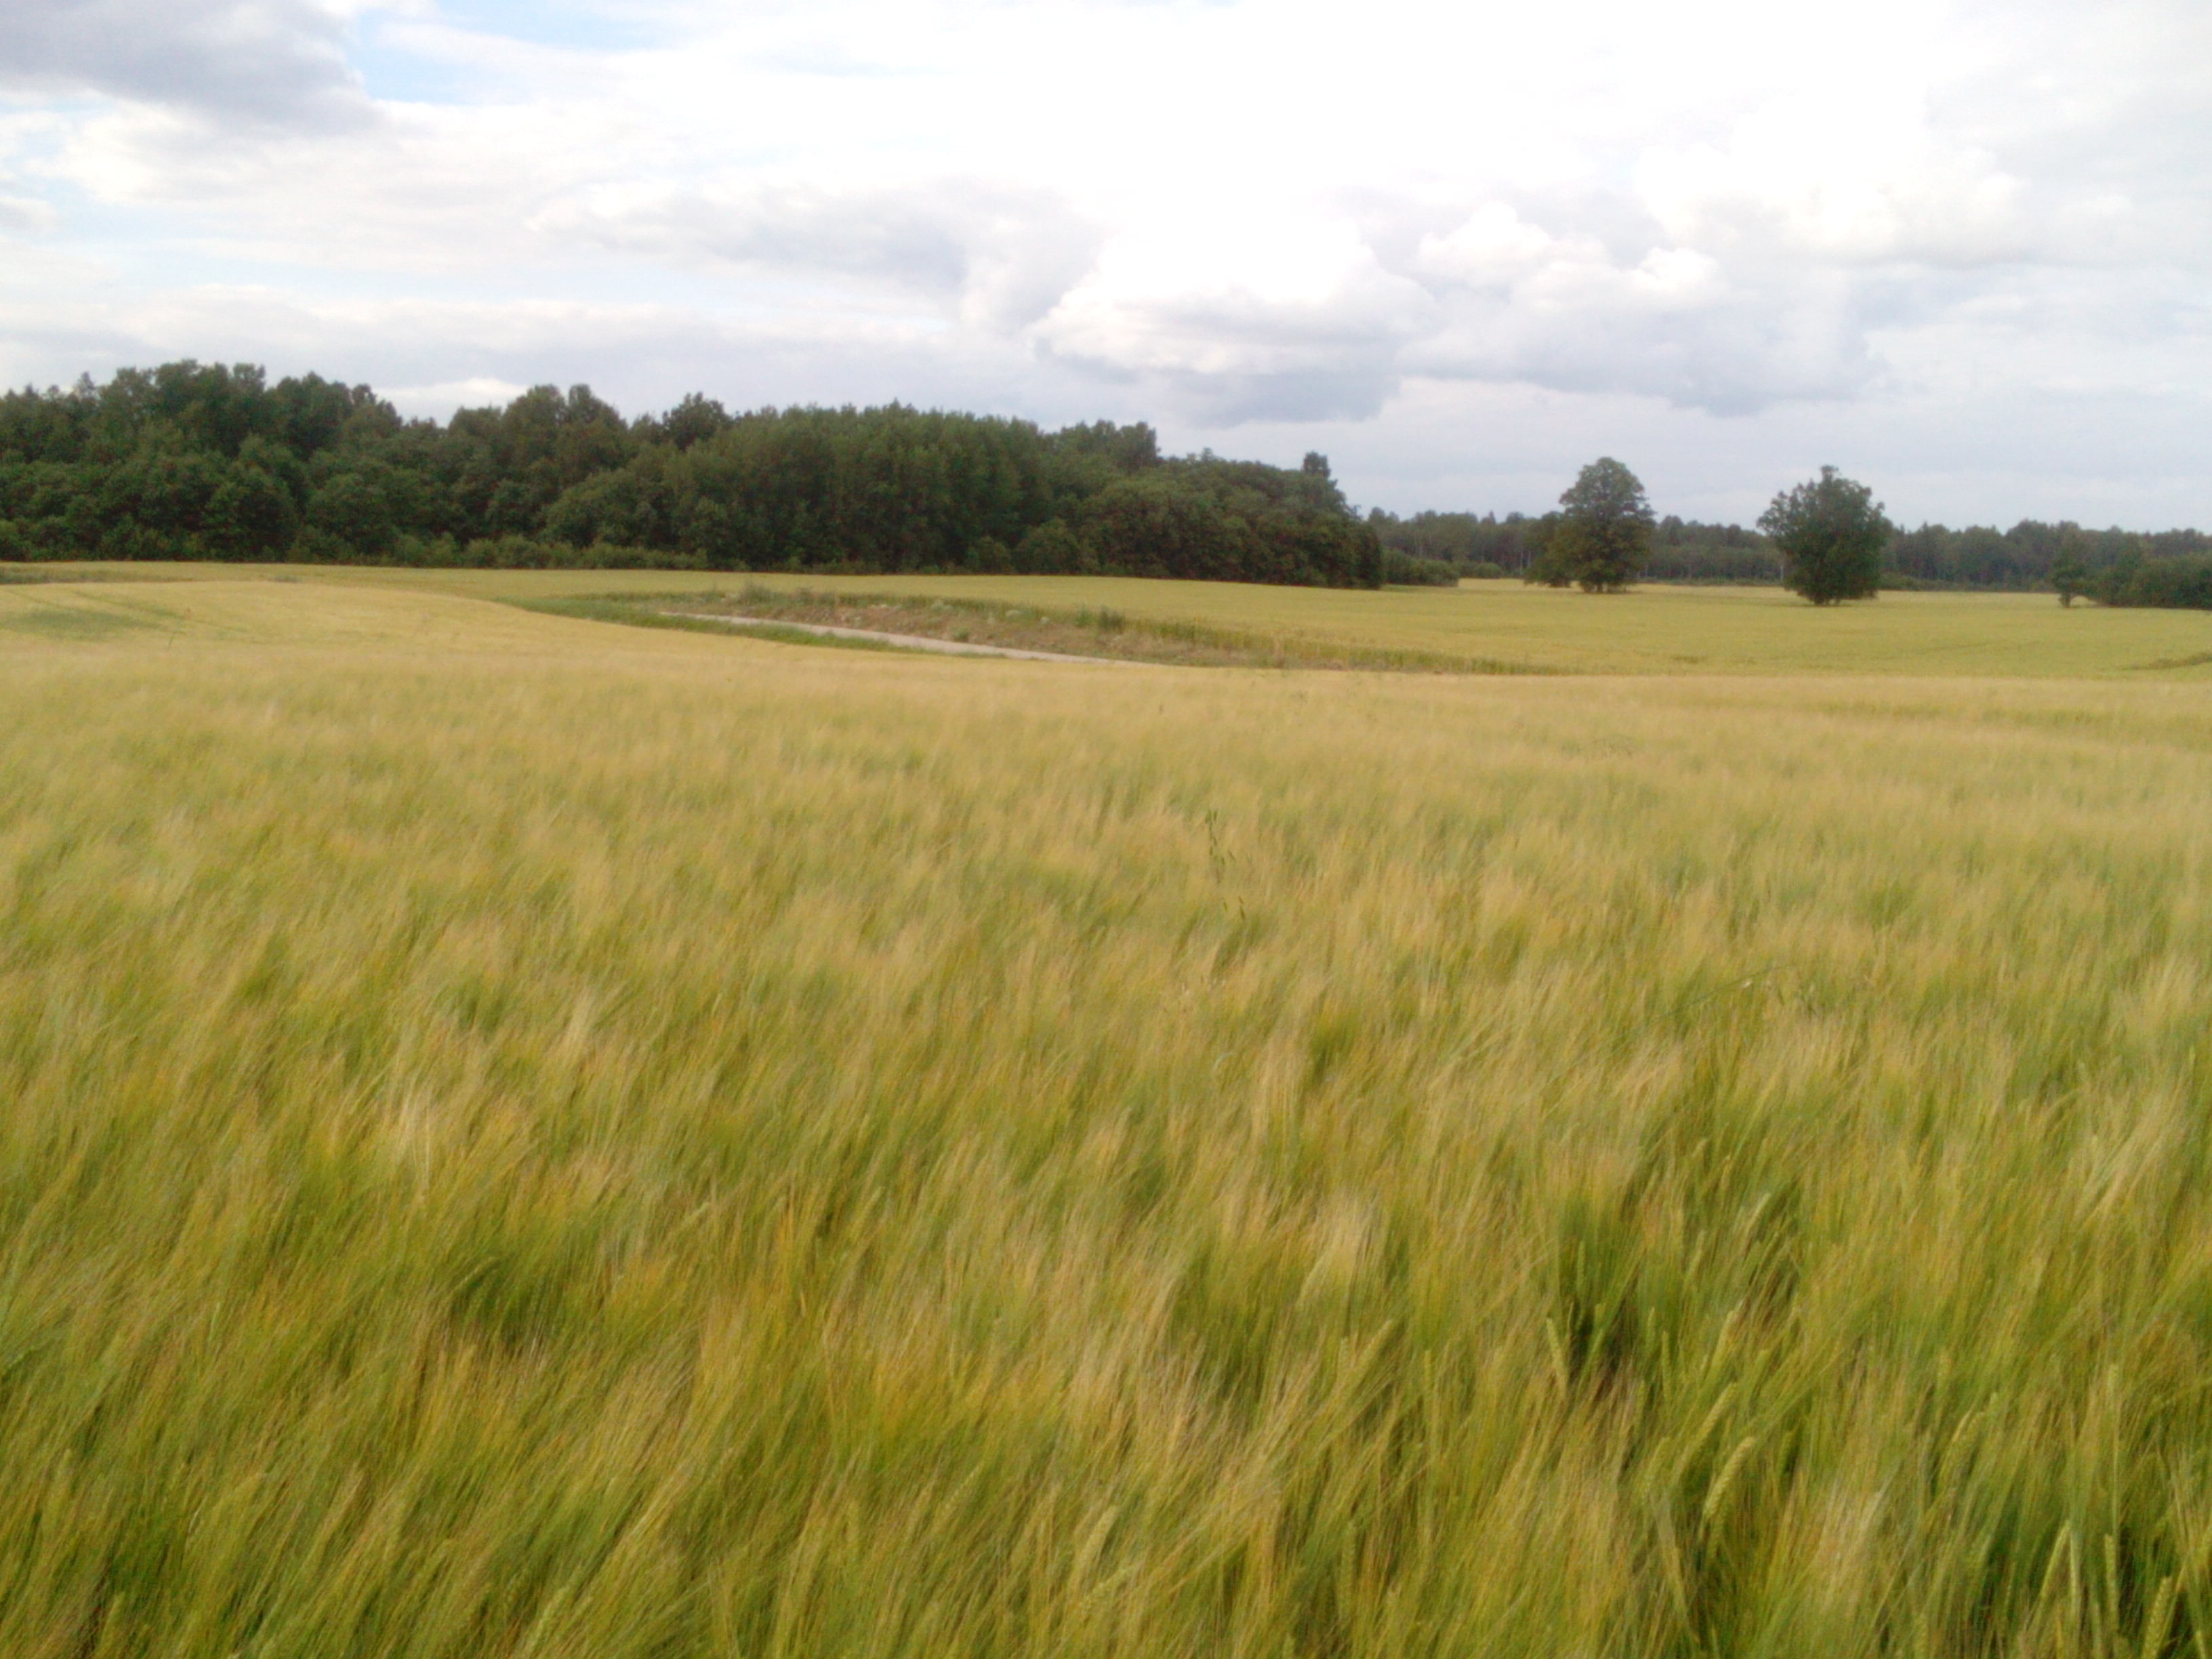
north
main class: Cropland
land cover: Barley
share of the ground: > 75 %
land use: Agriculture (excluding fallow land and kitchen gardens)
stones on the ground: 10 - 25 %
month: July
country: LV
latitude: 56.9114
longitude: 22.4212
